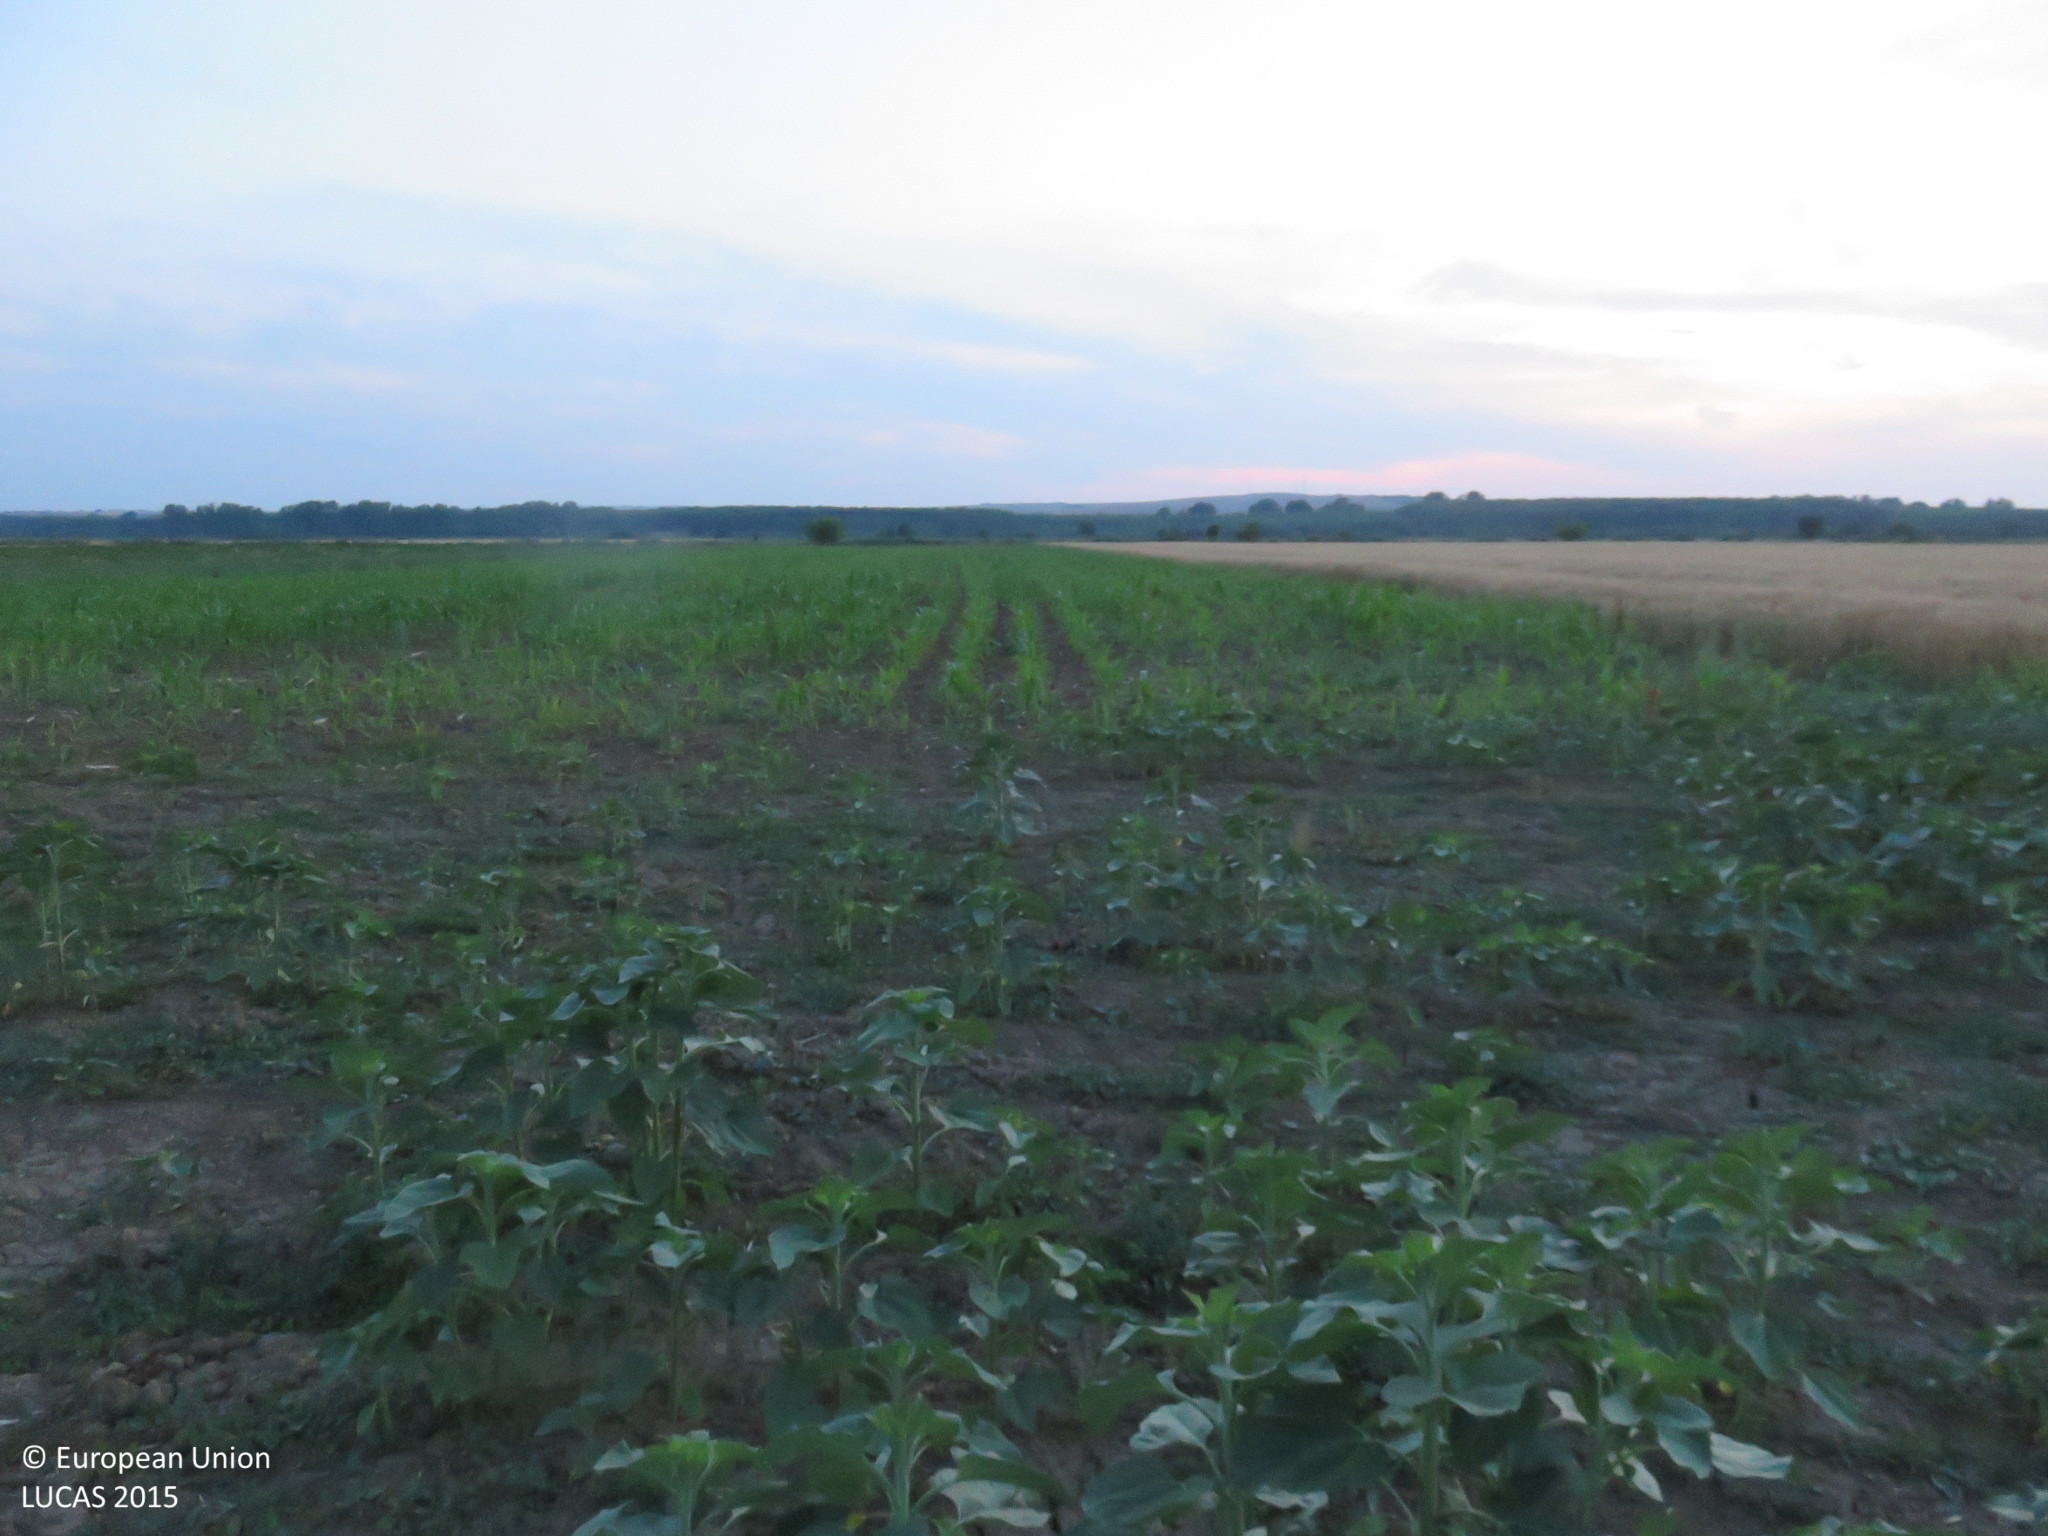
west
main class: Cropland
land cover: Sunflower
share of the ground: > 75 %
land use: Agriculture (excluding fallow land and kitchen gardens)
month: June
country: BG
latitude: 43.6963
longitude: 24.4684
